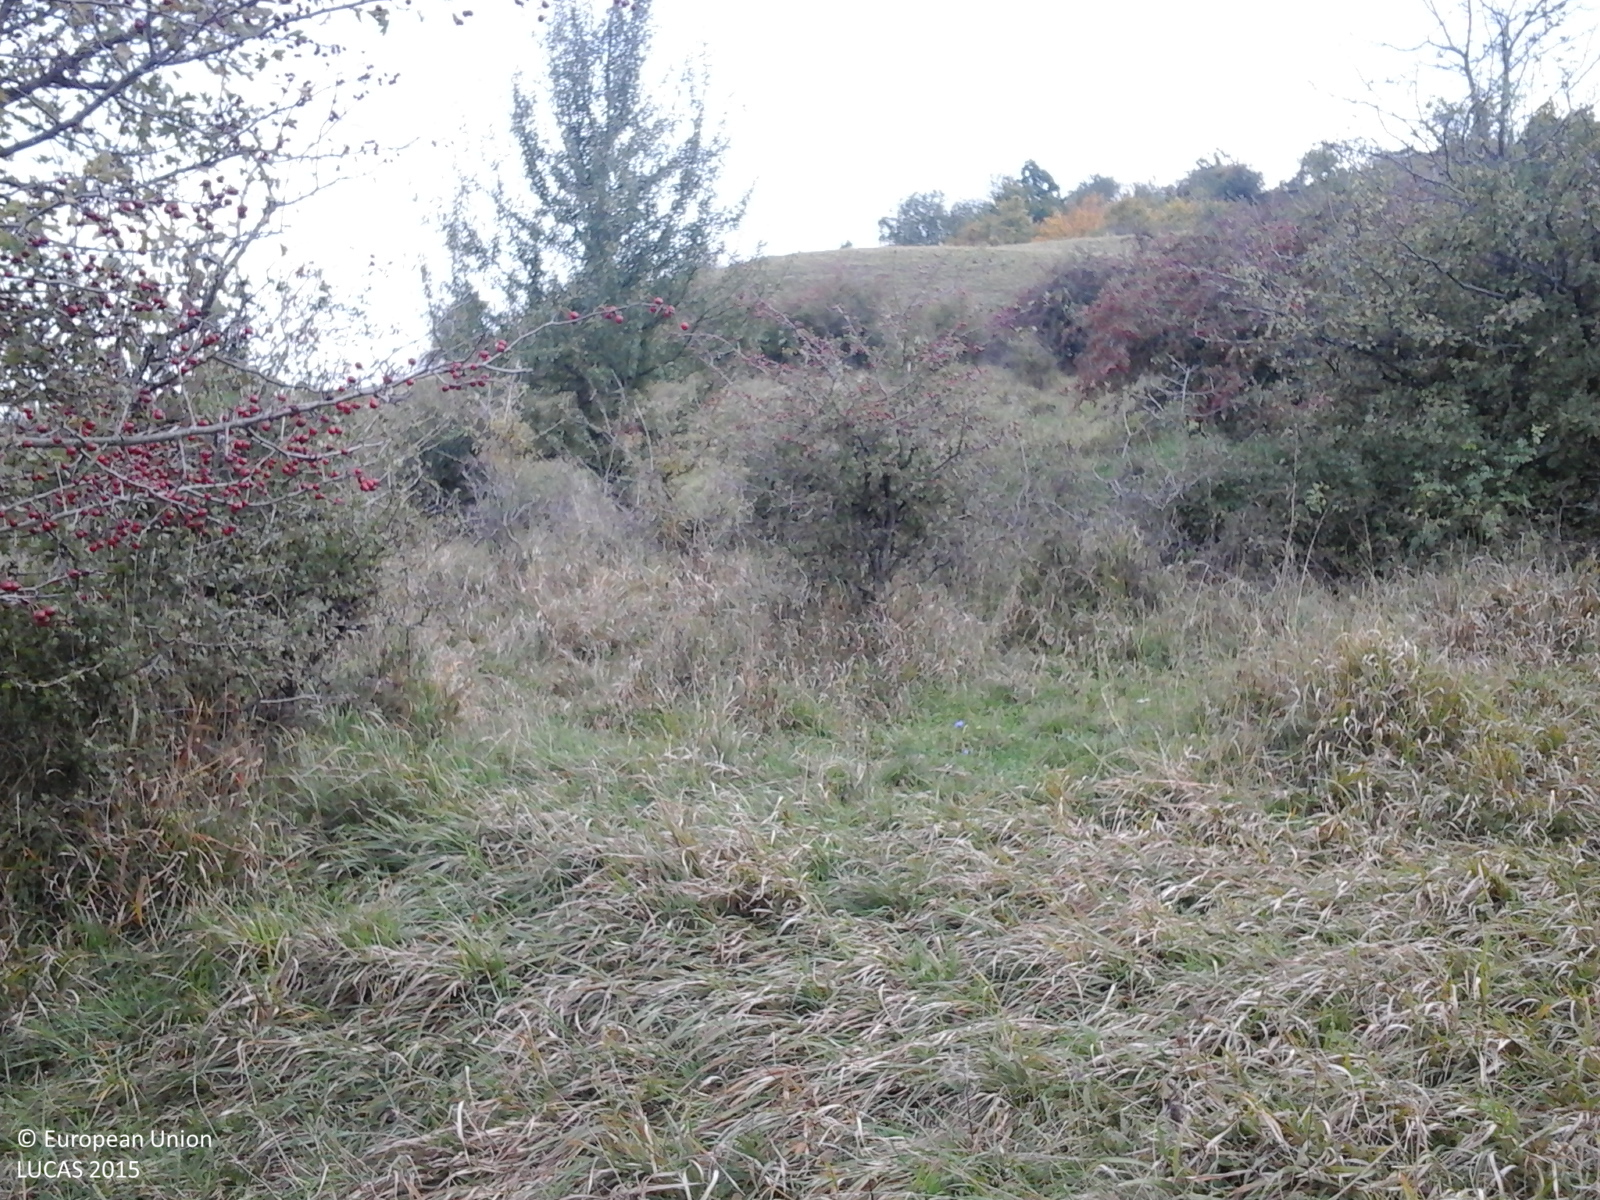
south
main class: Grassland
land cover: Grassland with sparse tree/shrub cover
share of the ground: > 75 %
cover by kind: herbaceous plants 85 %, shrubs 10 %, broadleaved forest trees 5 %
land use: Agriculture (excluding fallow land and kitchen gardens)
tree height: < 5 m
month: October
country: RO
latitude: 46.3057
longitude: 24.9089
